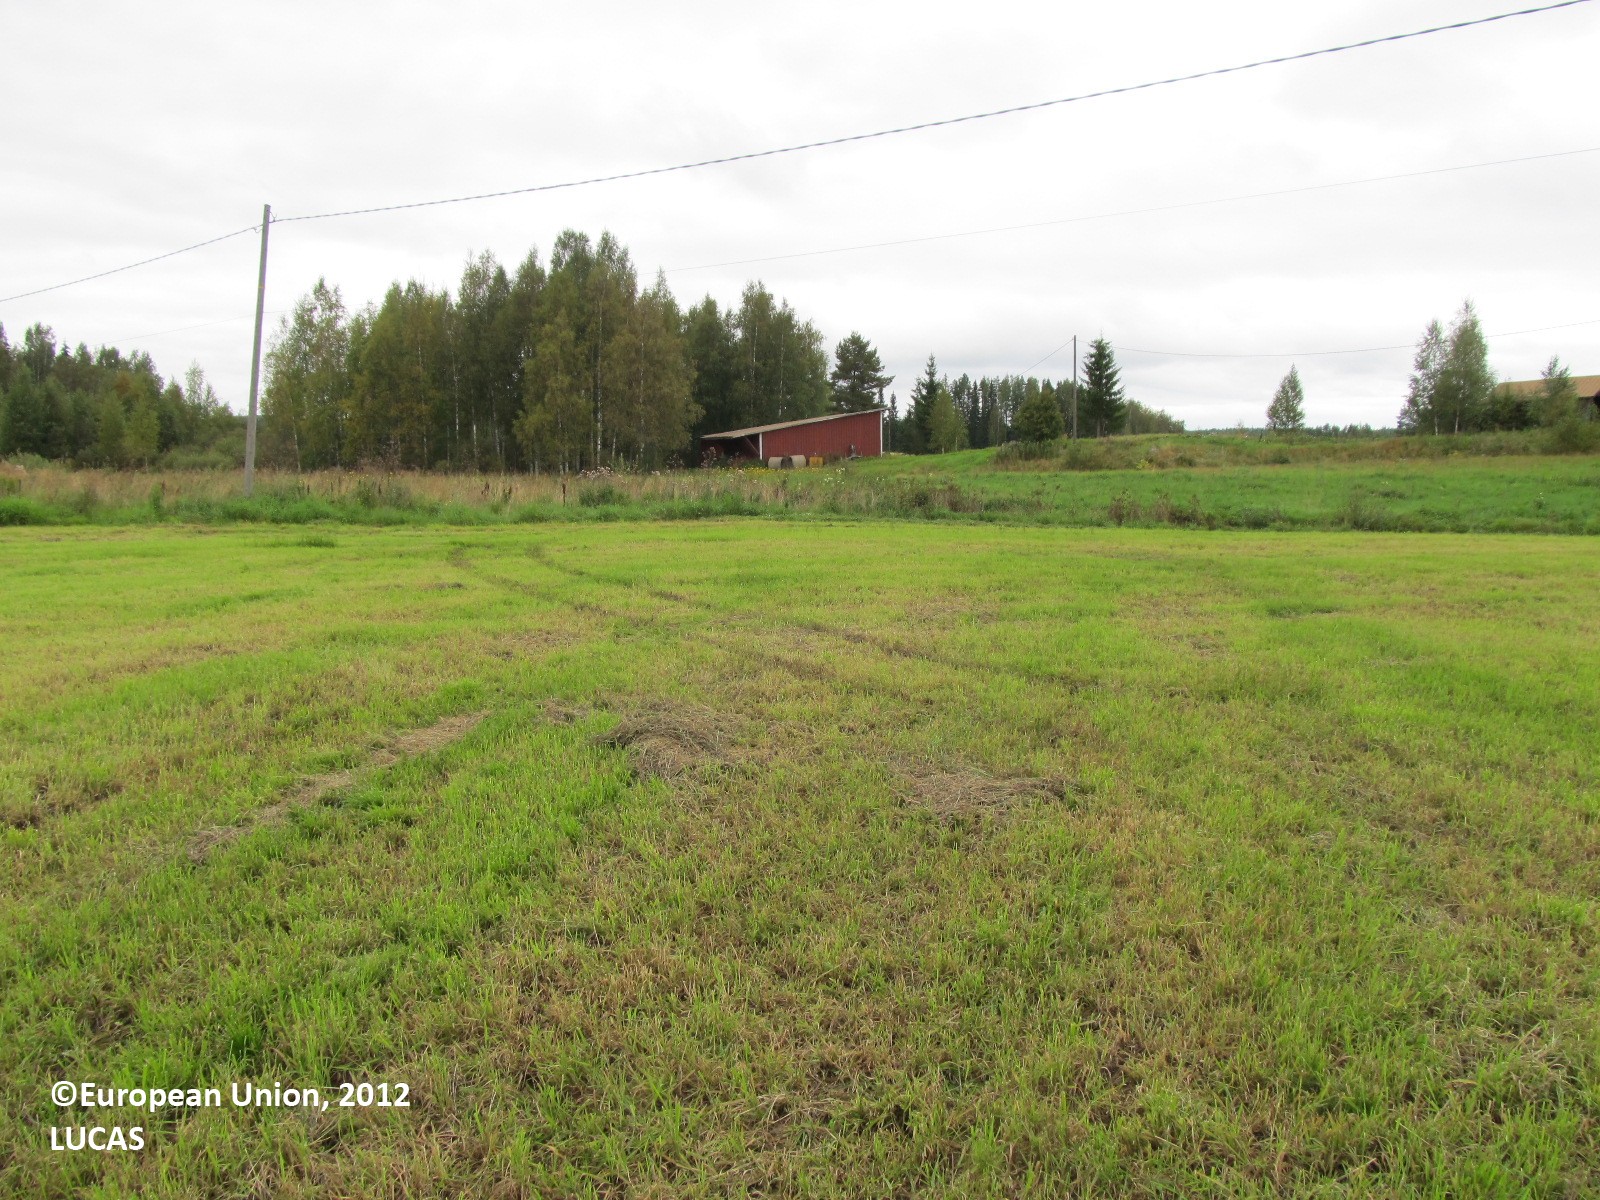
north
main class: Cropland
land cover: Temporary grasslands
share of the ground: 50 - 75 %
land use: Agriculture (excluding fallow land and kitchen gardens)
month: August
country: FI
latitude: 63.1757
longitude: 27.6232
